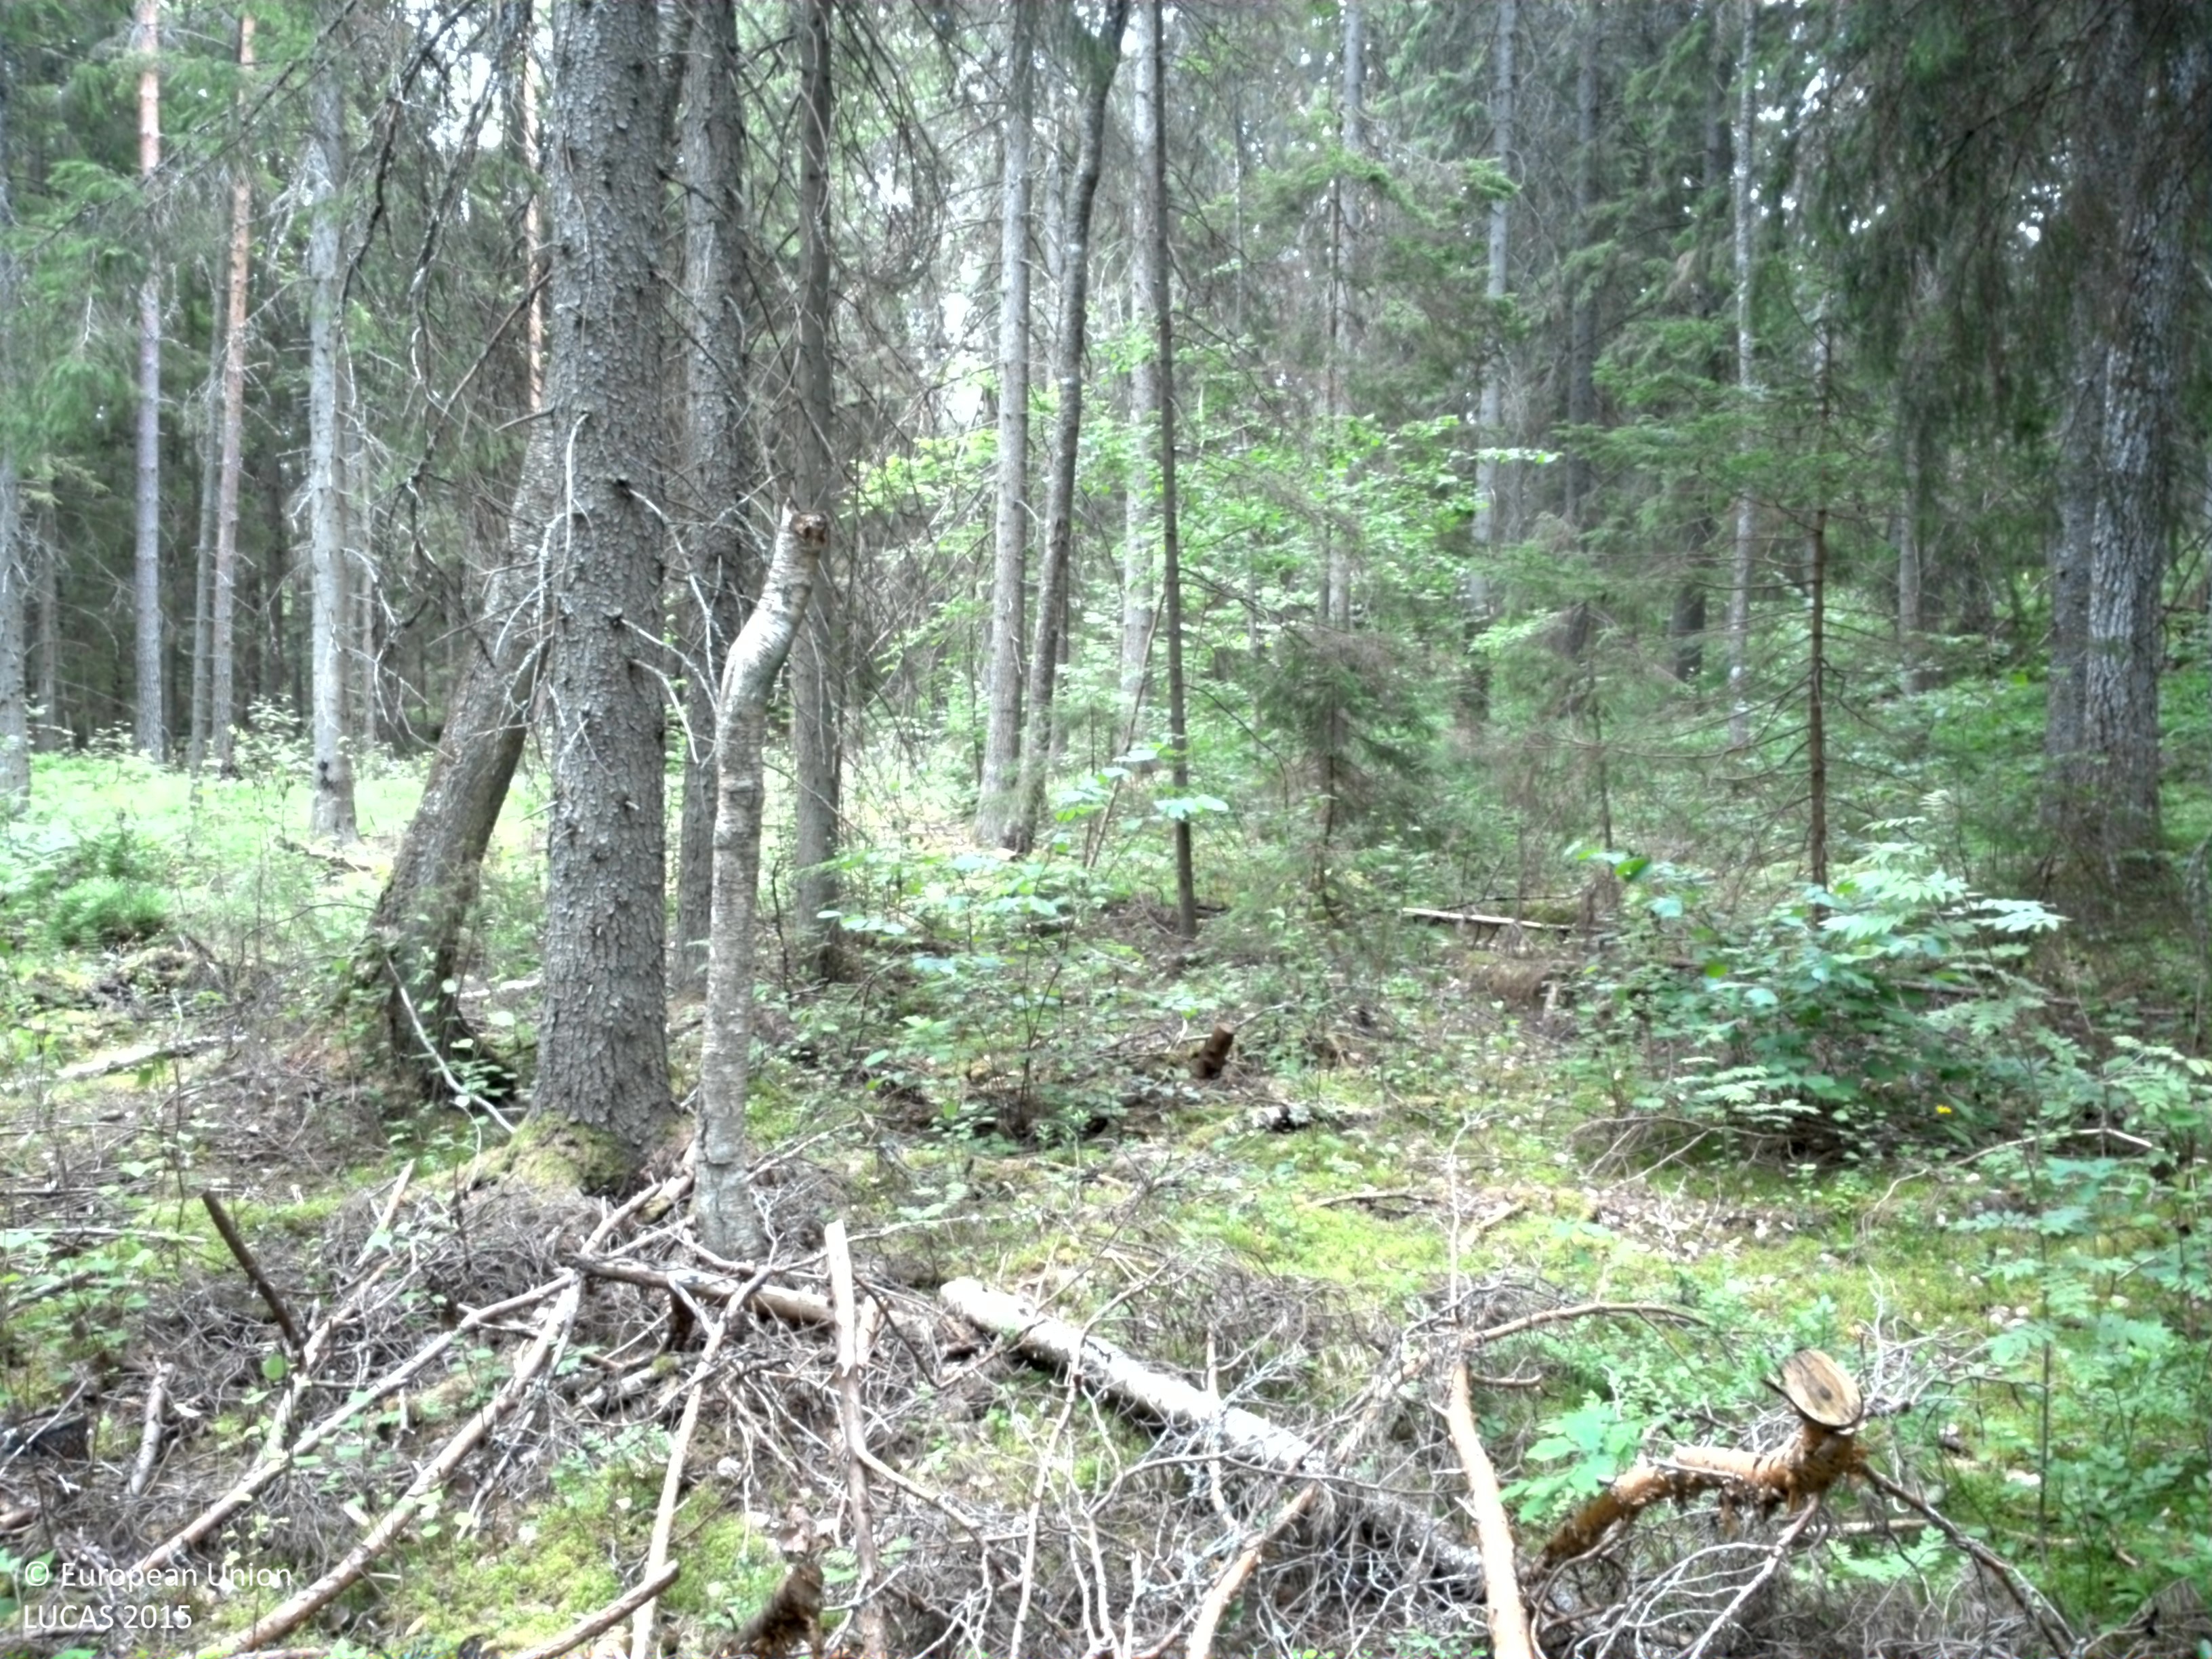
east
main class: Woodland
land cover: Spruce dominated coniferous woodland
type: boreal forest
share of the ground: > 75 %
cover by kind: coniferous forest trees 70 %, broadleaved forest trees 10 %, herbaceous plants 10 %, lichens and mosses 10 %
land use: Forestry
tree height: > 5 m
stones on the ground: < 10 %
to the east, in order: Spruce dominated coniferous woodland; Tracks; Spruce dominated coniferous woodland; Rivers and streams; Spruce dominated coniferous woodland; Spruce dominated mixed woodland; Grassland with sparse tree/shrub cover; Oats
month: July
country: SE
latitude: 60.0199
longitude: 18.4113
